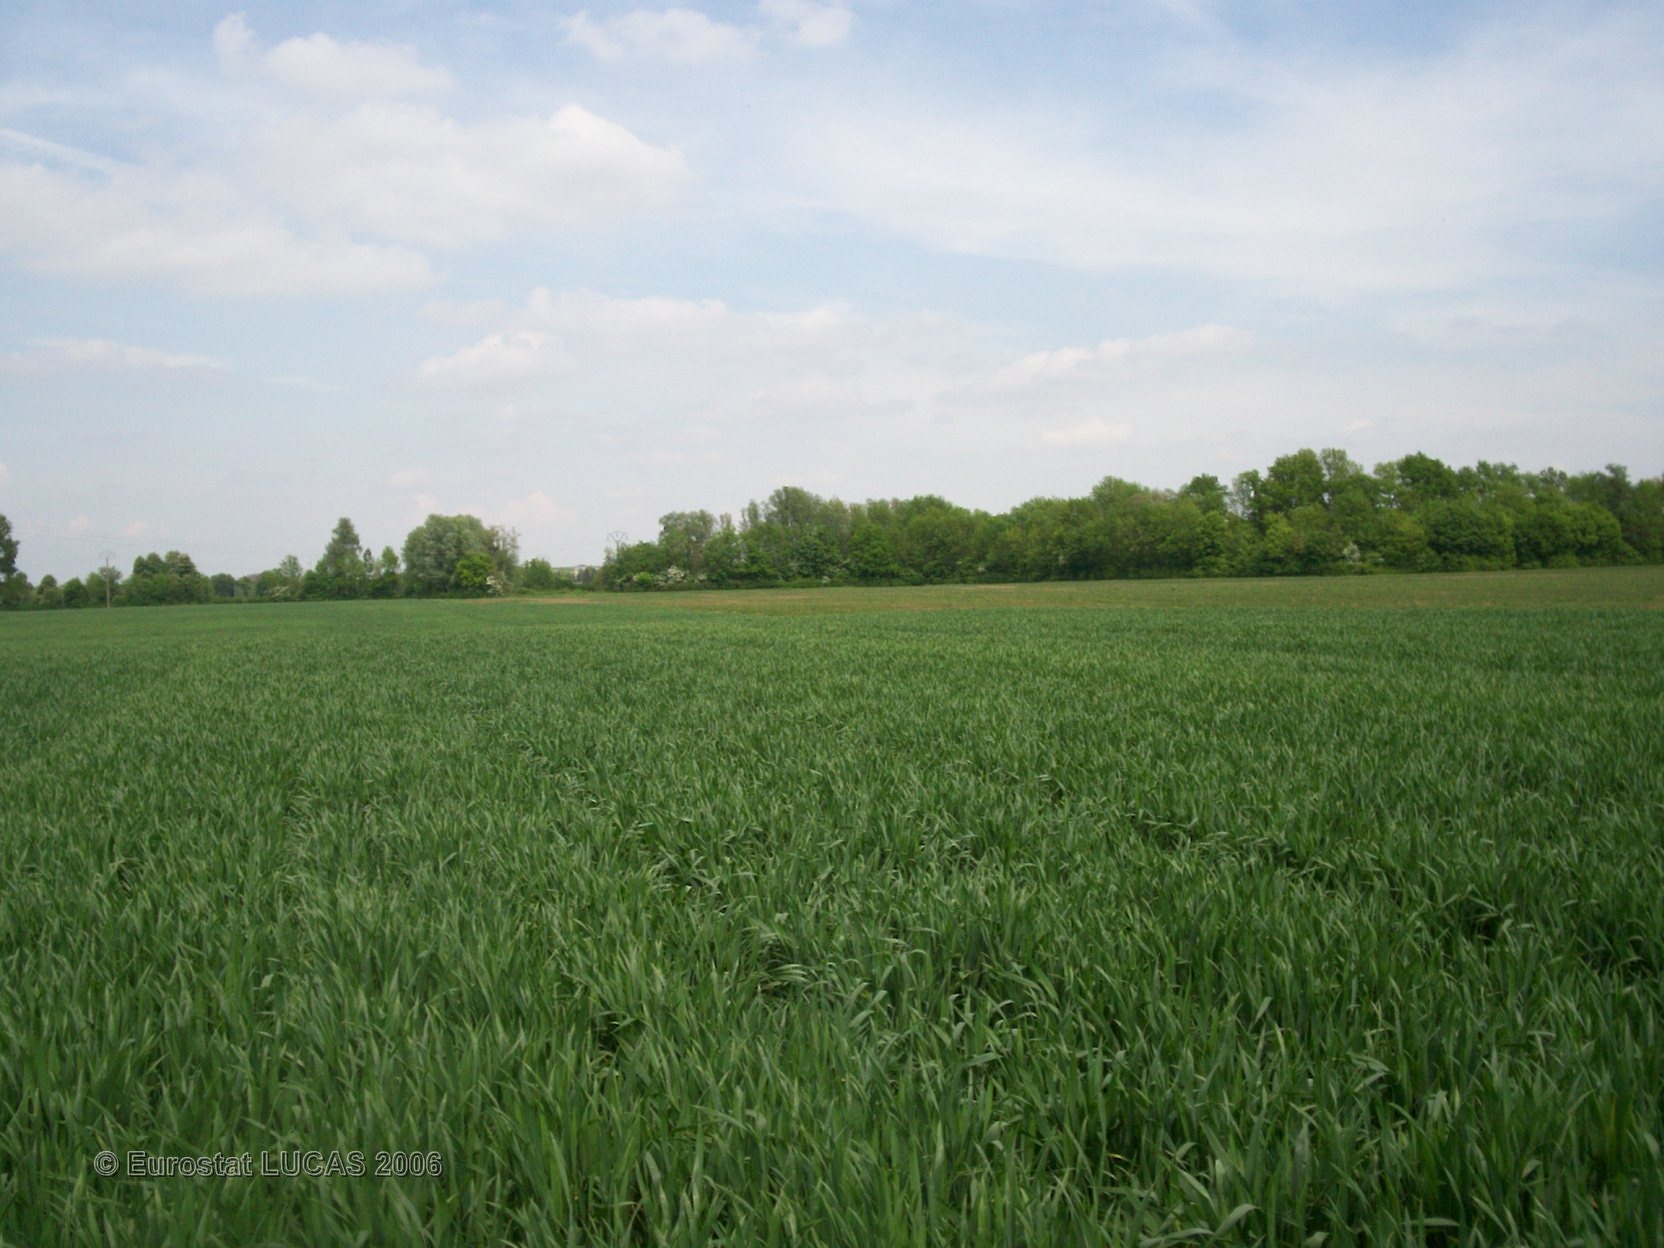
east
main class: Cropland
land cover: Common wheat
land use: Agriculture (excluding fallow land and kitchen gardens)
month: May
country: FR
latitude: 48.9282
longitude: 4.3866
